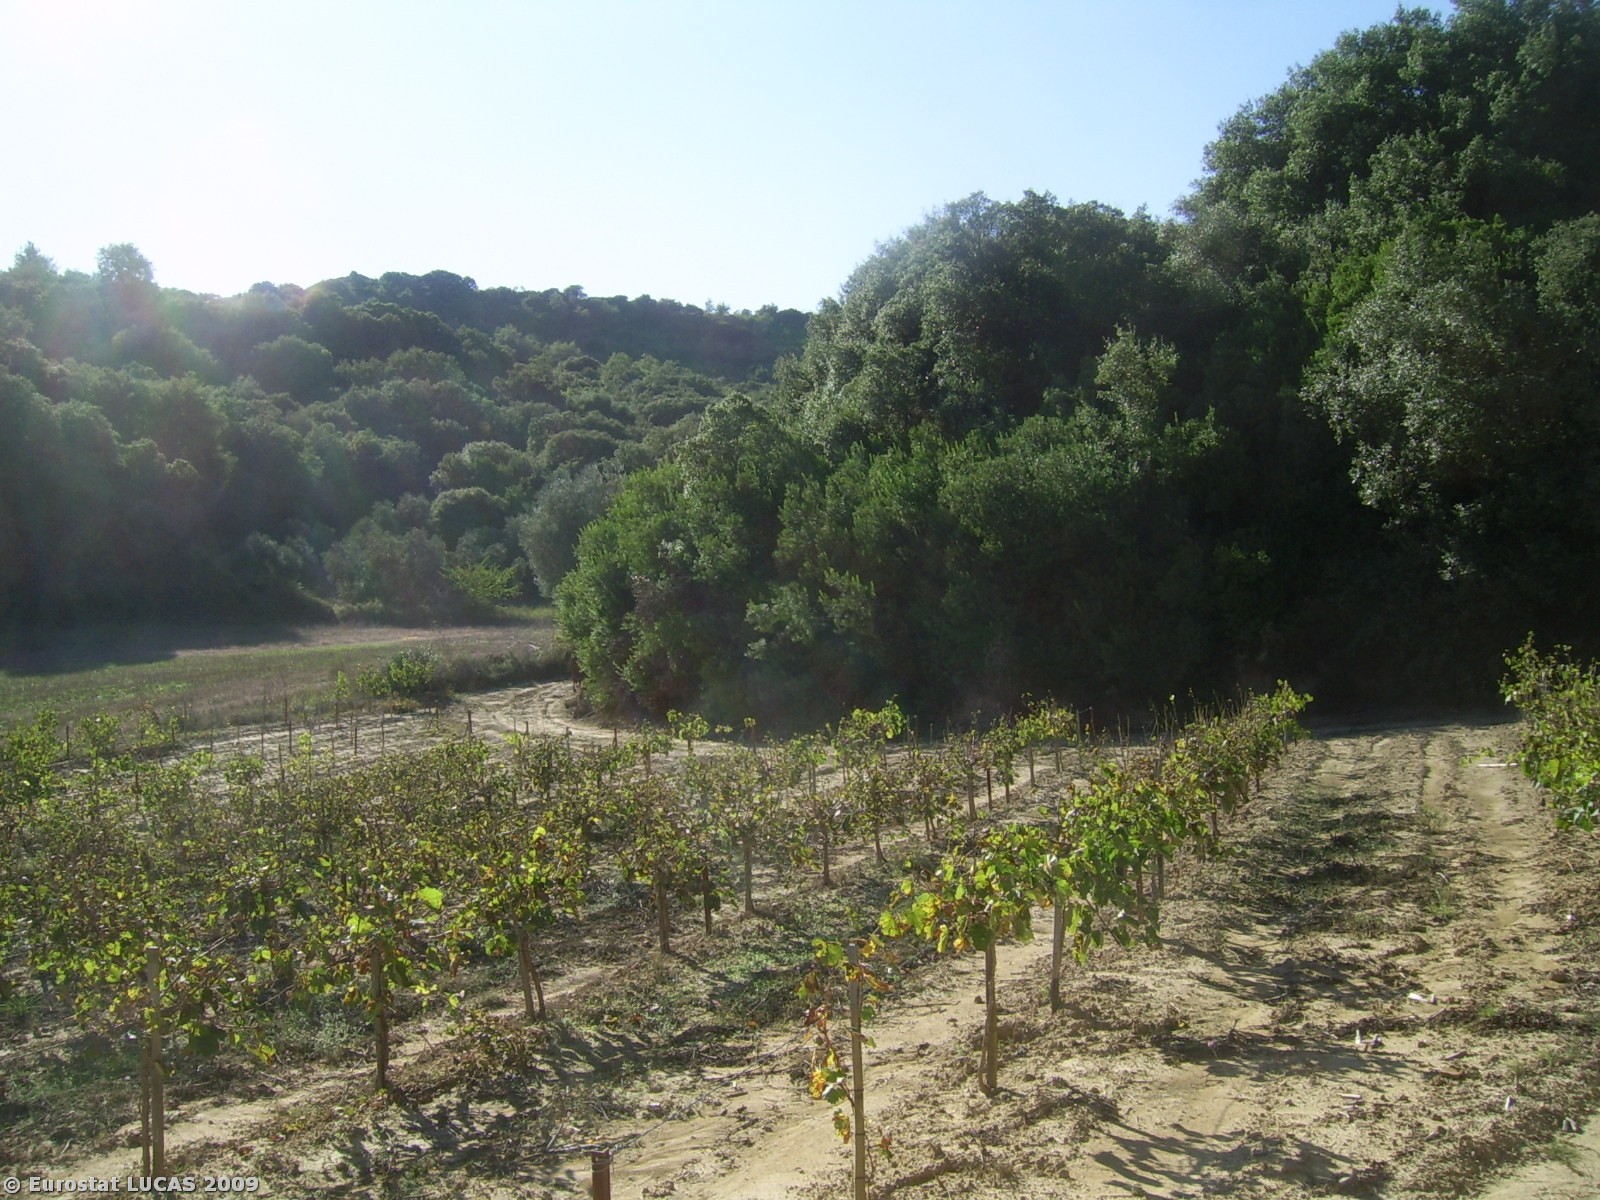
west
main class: Shrubland
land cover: Shrubland with sparse tree cover
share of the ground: > 75 %
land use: Unused
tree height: > 5 m
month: October
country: GR
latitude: 37.8817
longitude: 21.4104
